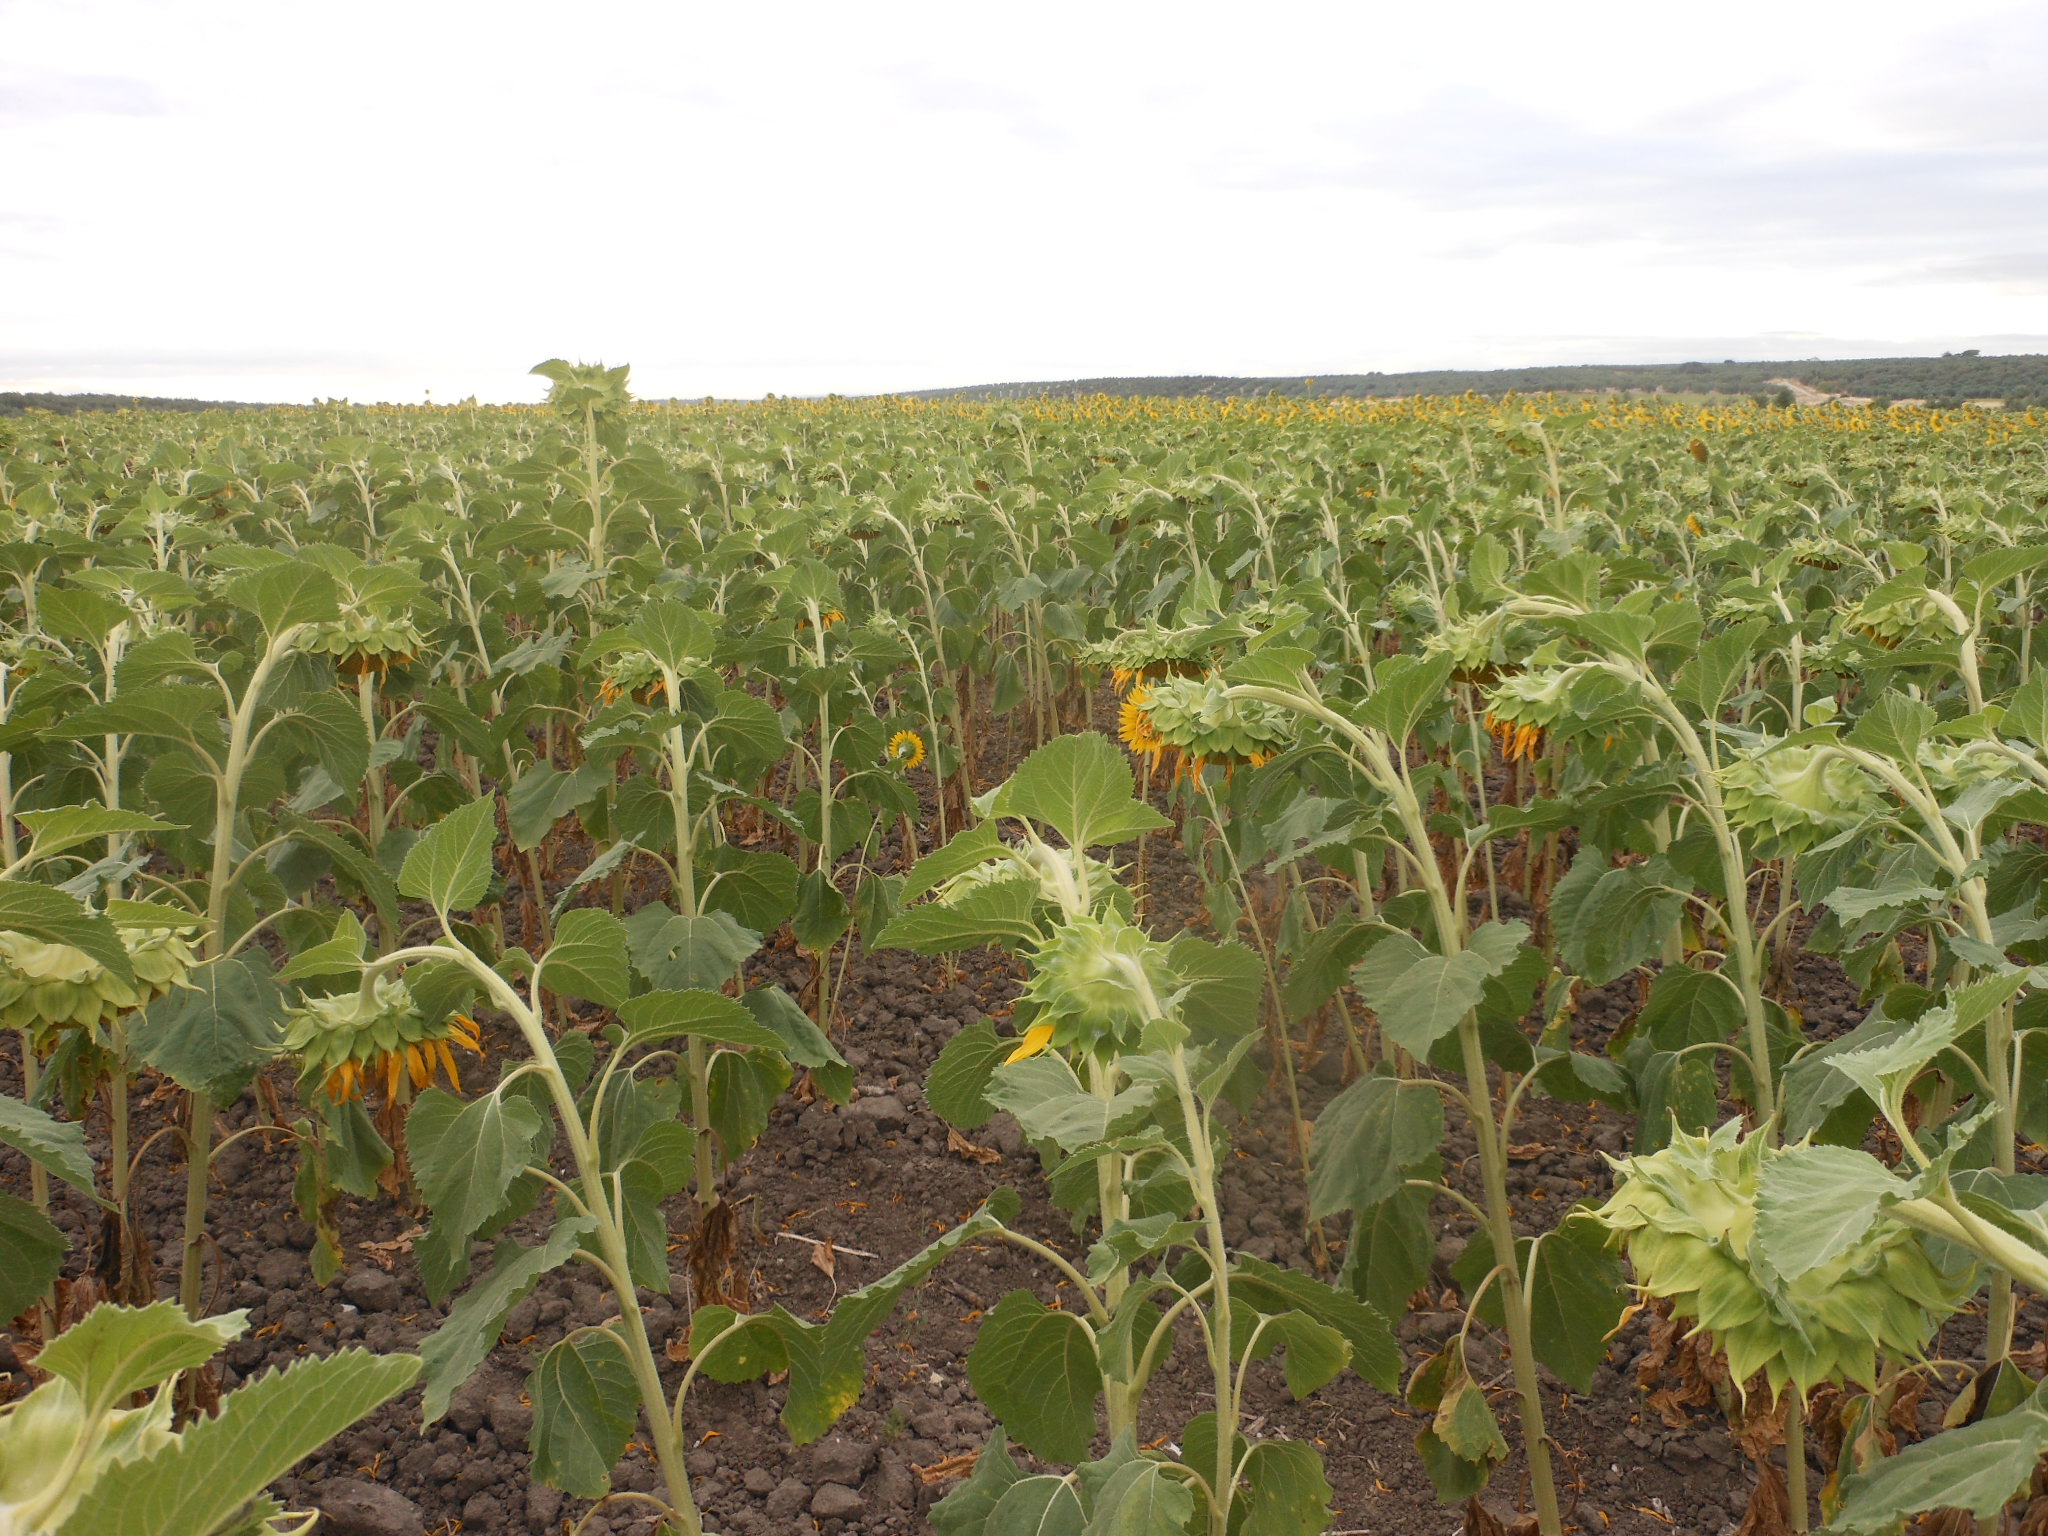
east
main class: Cropland
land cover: Sunflower
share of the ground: 50 - 75 %
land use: Agriculture (excluding fallow land and kitchen gardens)
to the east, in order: Sunflower; Grass margins; Olive groves; Grass margins
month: June
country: ES
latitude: 37.2576
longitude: -5.5171
